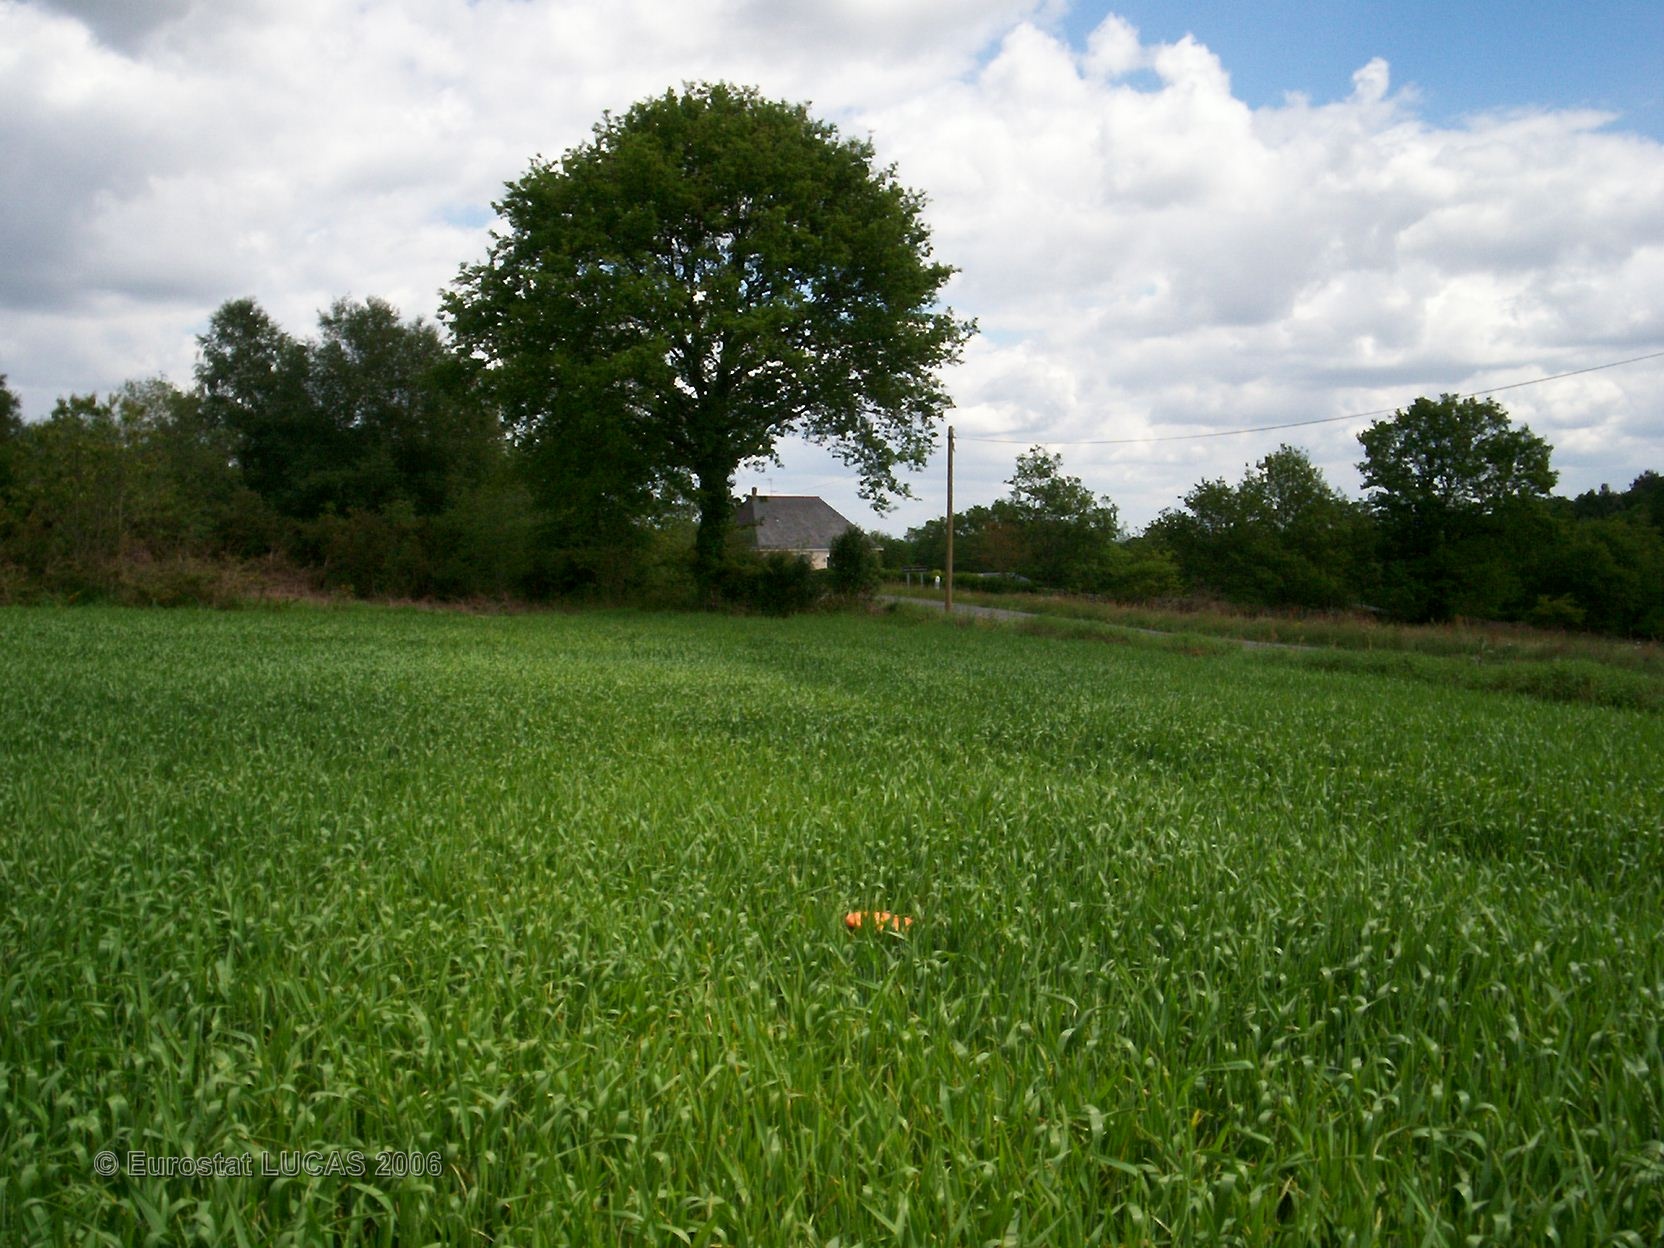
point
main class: Cropland
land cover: Common wheat
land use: Agriculture (excluding fallow land and kitchen gardens)
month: May
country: FR
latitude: 47.7415
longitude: -2.6908
